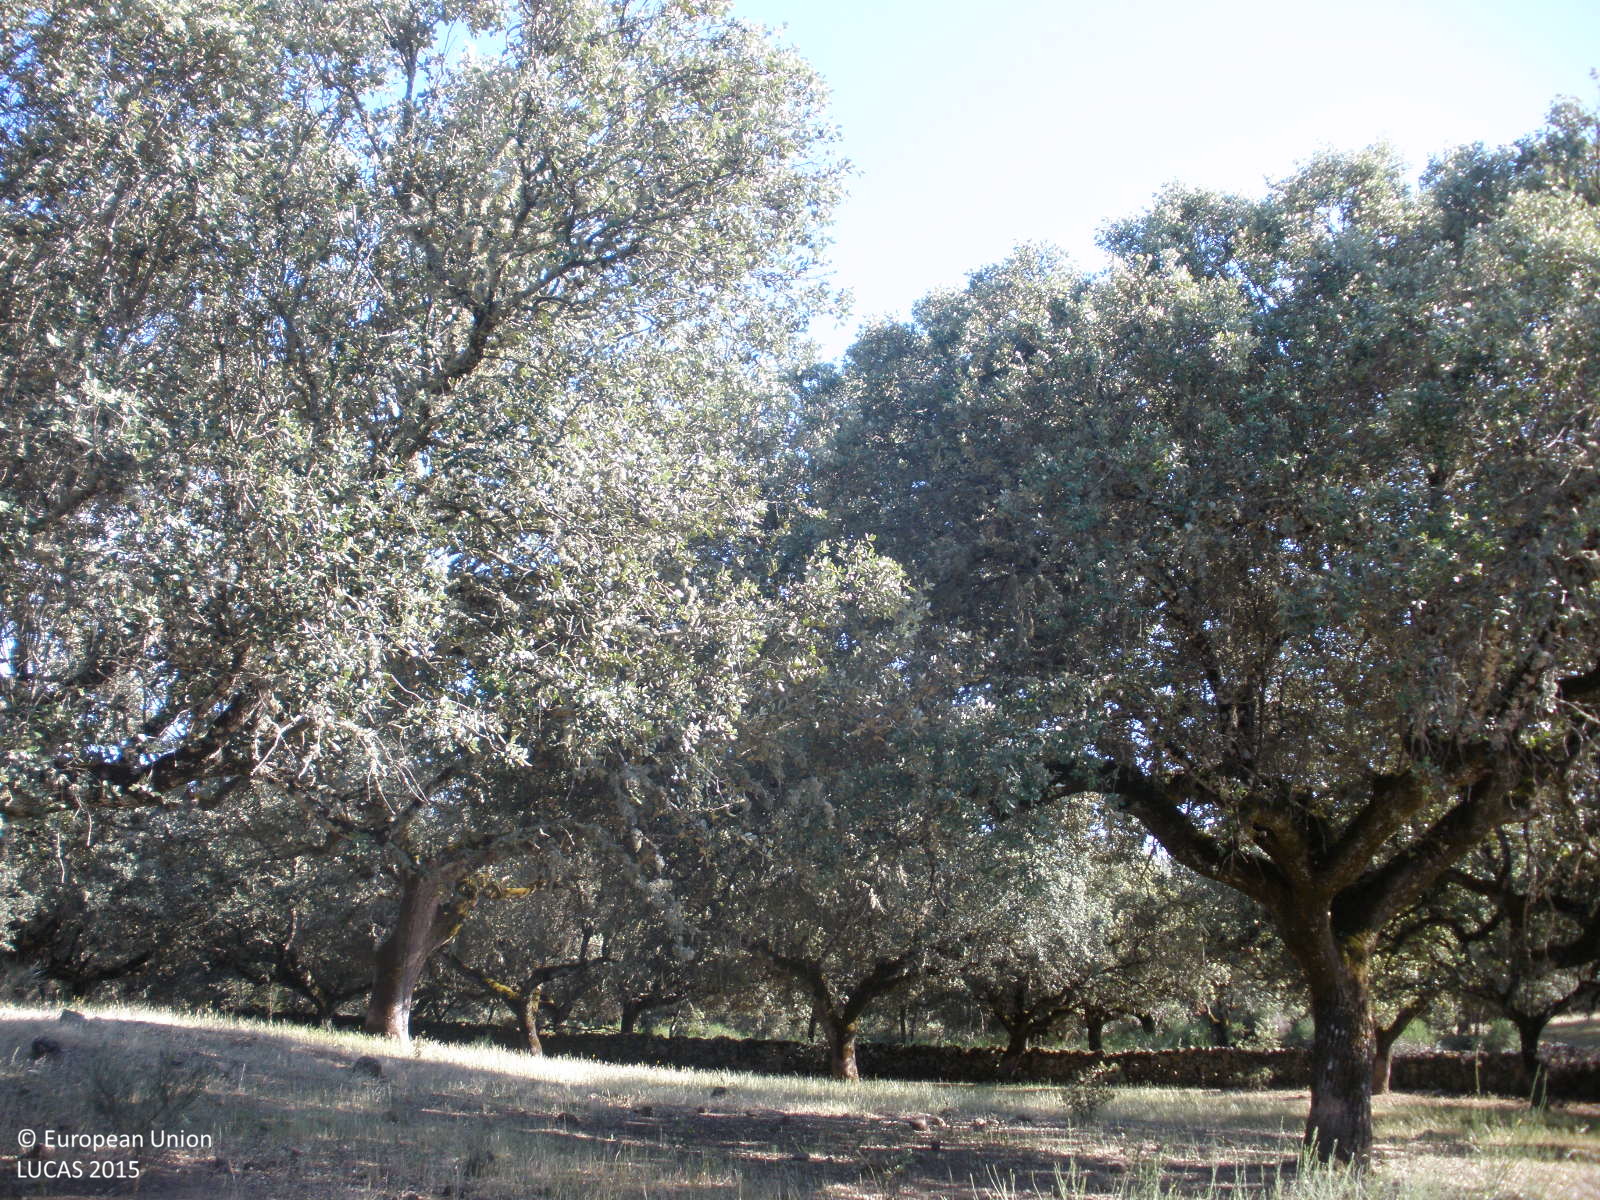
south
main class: Woodland
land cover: Broadleaved woodland
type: broadleaved evergreen forest
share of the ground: 50 - 75 %
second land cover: Grassland without tree/shrub cover
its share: > 75 %
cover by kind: broadleaved forest trees 70 %, herbaceous plants 30 %
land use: Forestry
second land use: Agriculture (excluding fallow land and kitchen gardens)
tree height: > 5 m
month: May
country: ES
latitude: 40.1340
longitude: -6.2609
